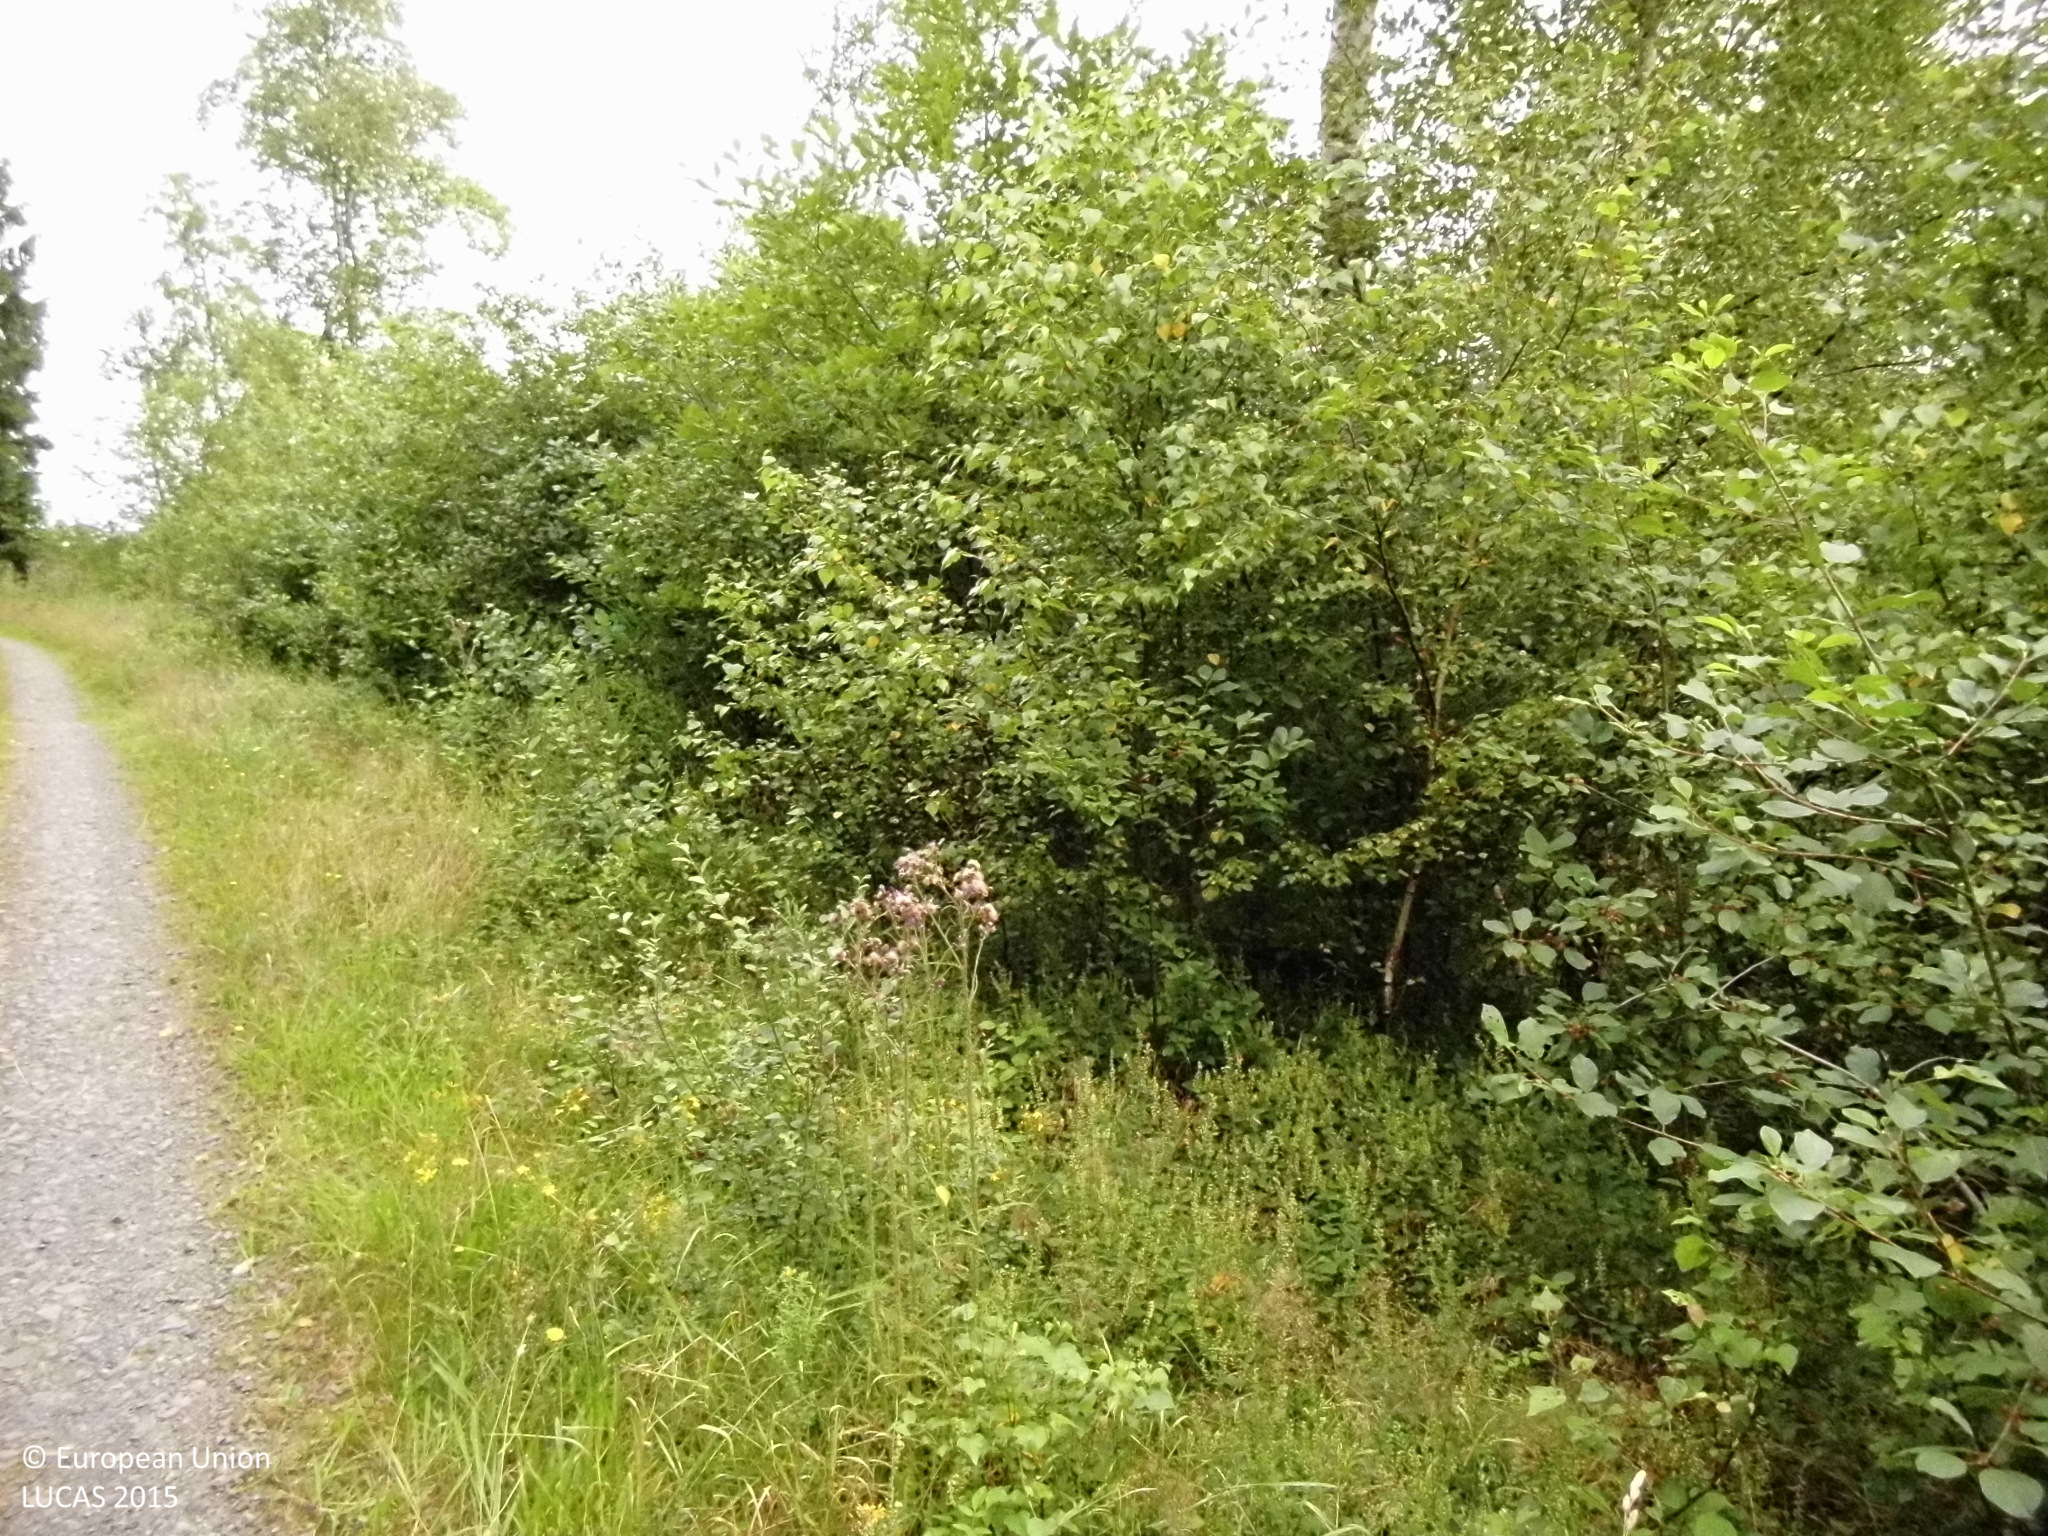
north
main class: Woodland
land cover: Broadleaved woodland
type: mesophytic deciduous forest
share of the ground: > 75 %
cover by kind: broadleaved forest trees 100 %
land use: Forestry
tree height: > 5 m
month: August
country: DE
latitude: 50.9599
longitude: 8.1068
